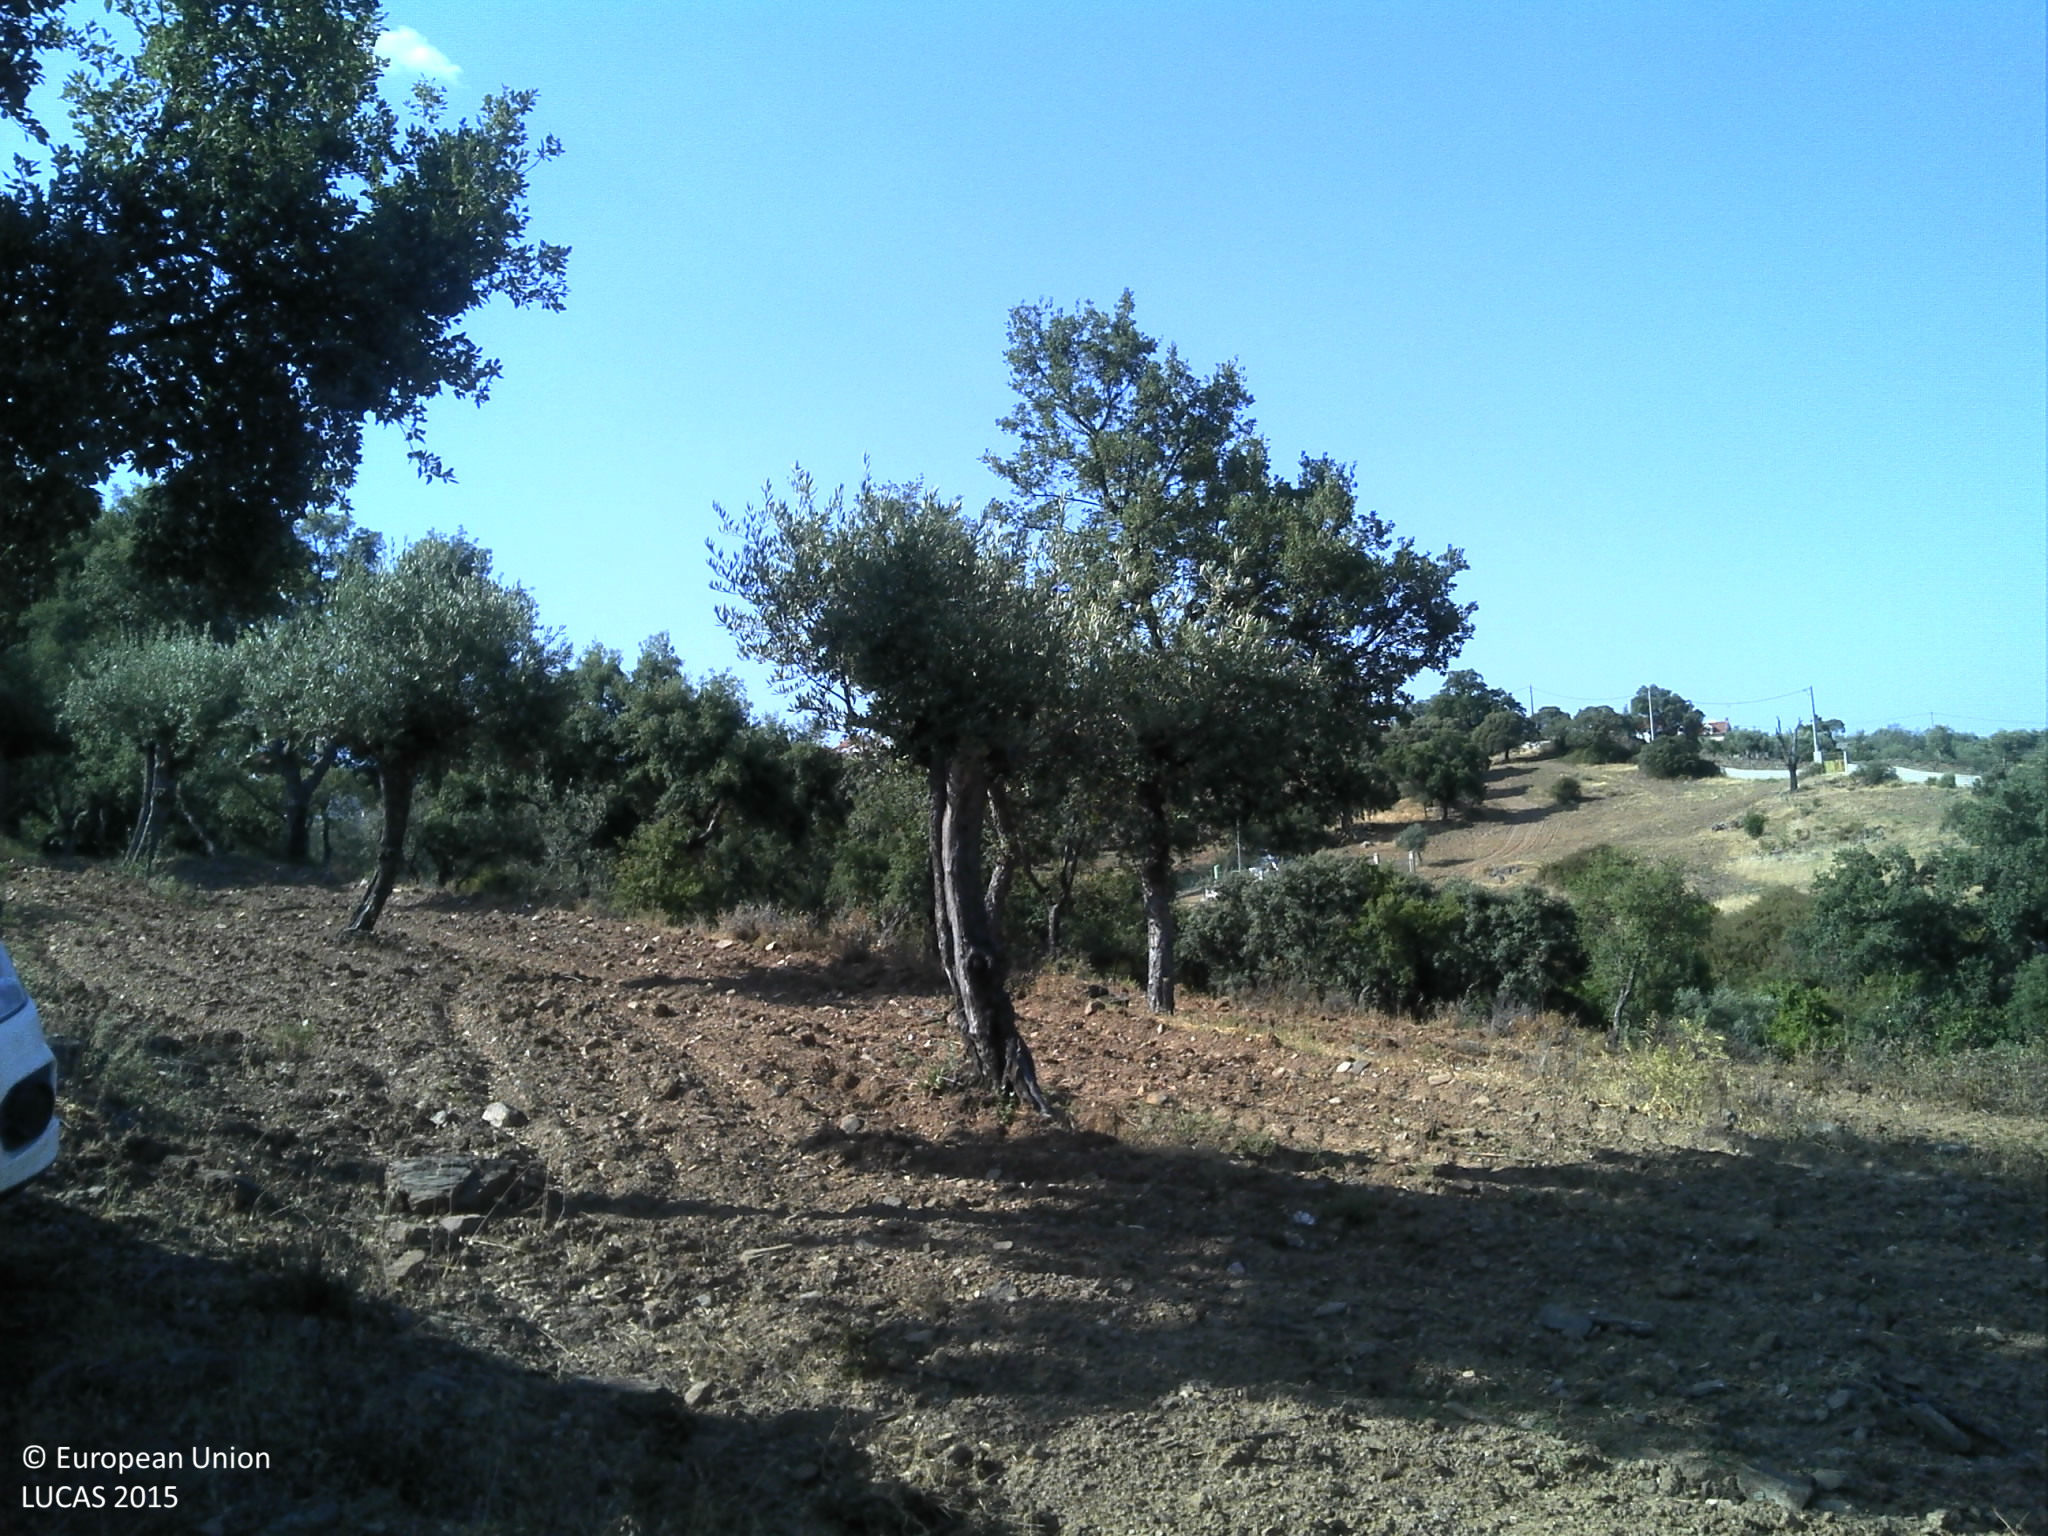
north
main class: Cropland
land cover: Olive groves
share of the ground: 25 - 50 %
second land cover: Spontaneously vegetated surfaces
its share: 10 - 25 %
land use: Agriculture (excluding fallow land and kitchen gardens)
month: June
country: PT
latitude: 39.8899
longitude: -7.3461
